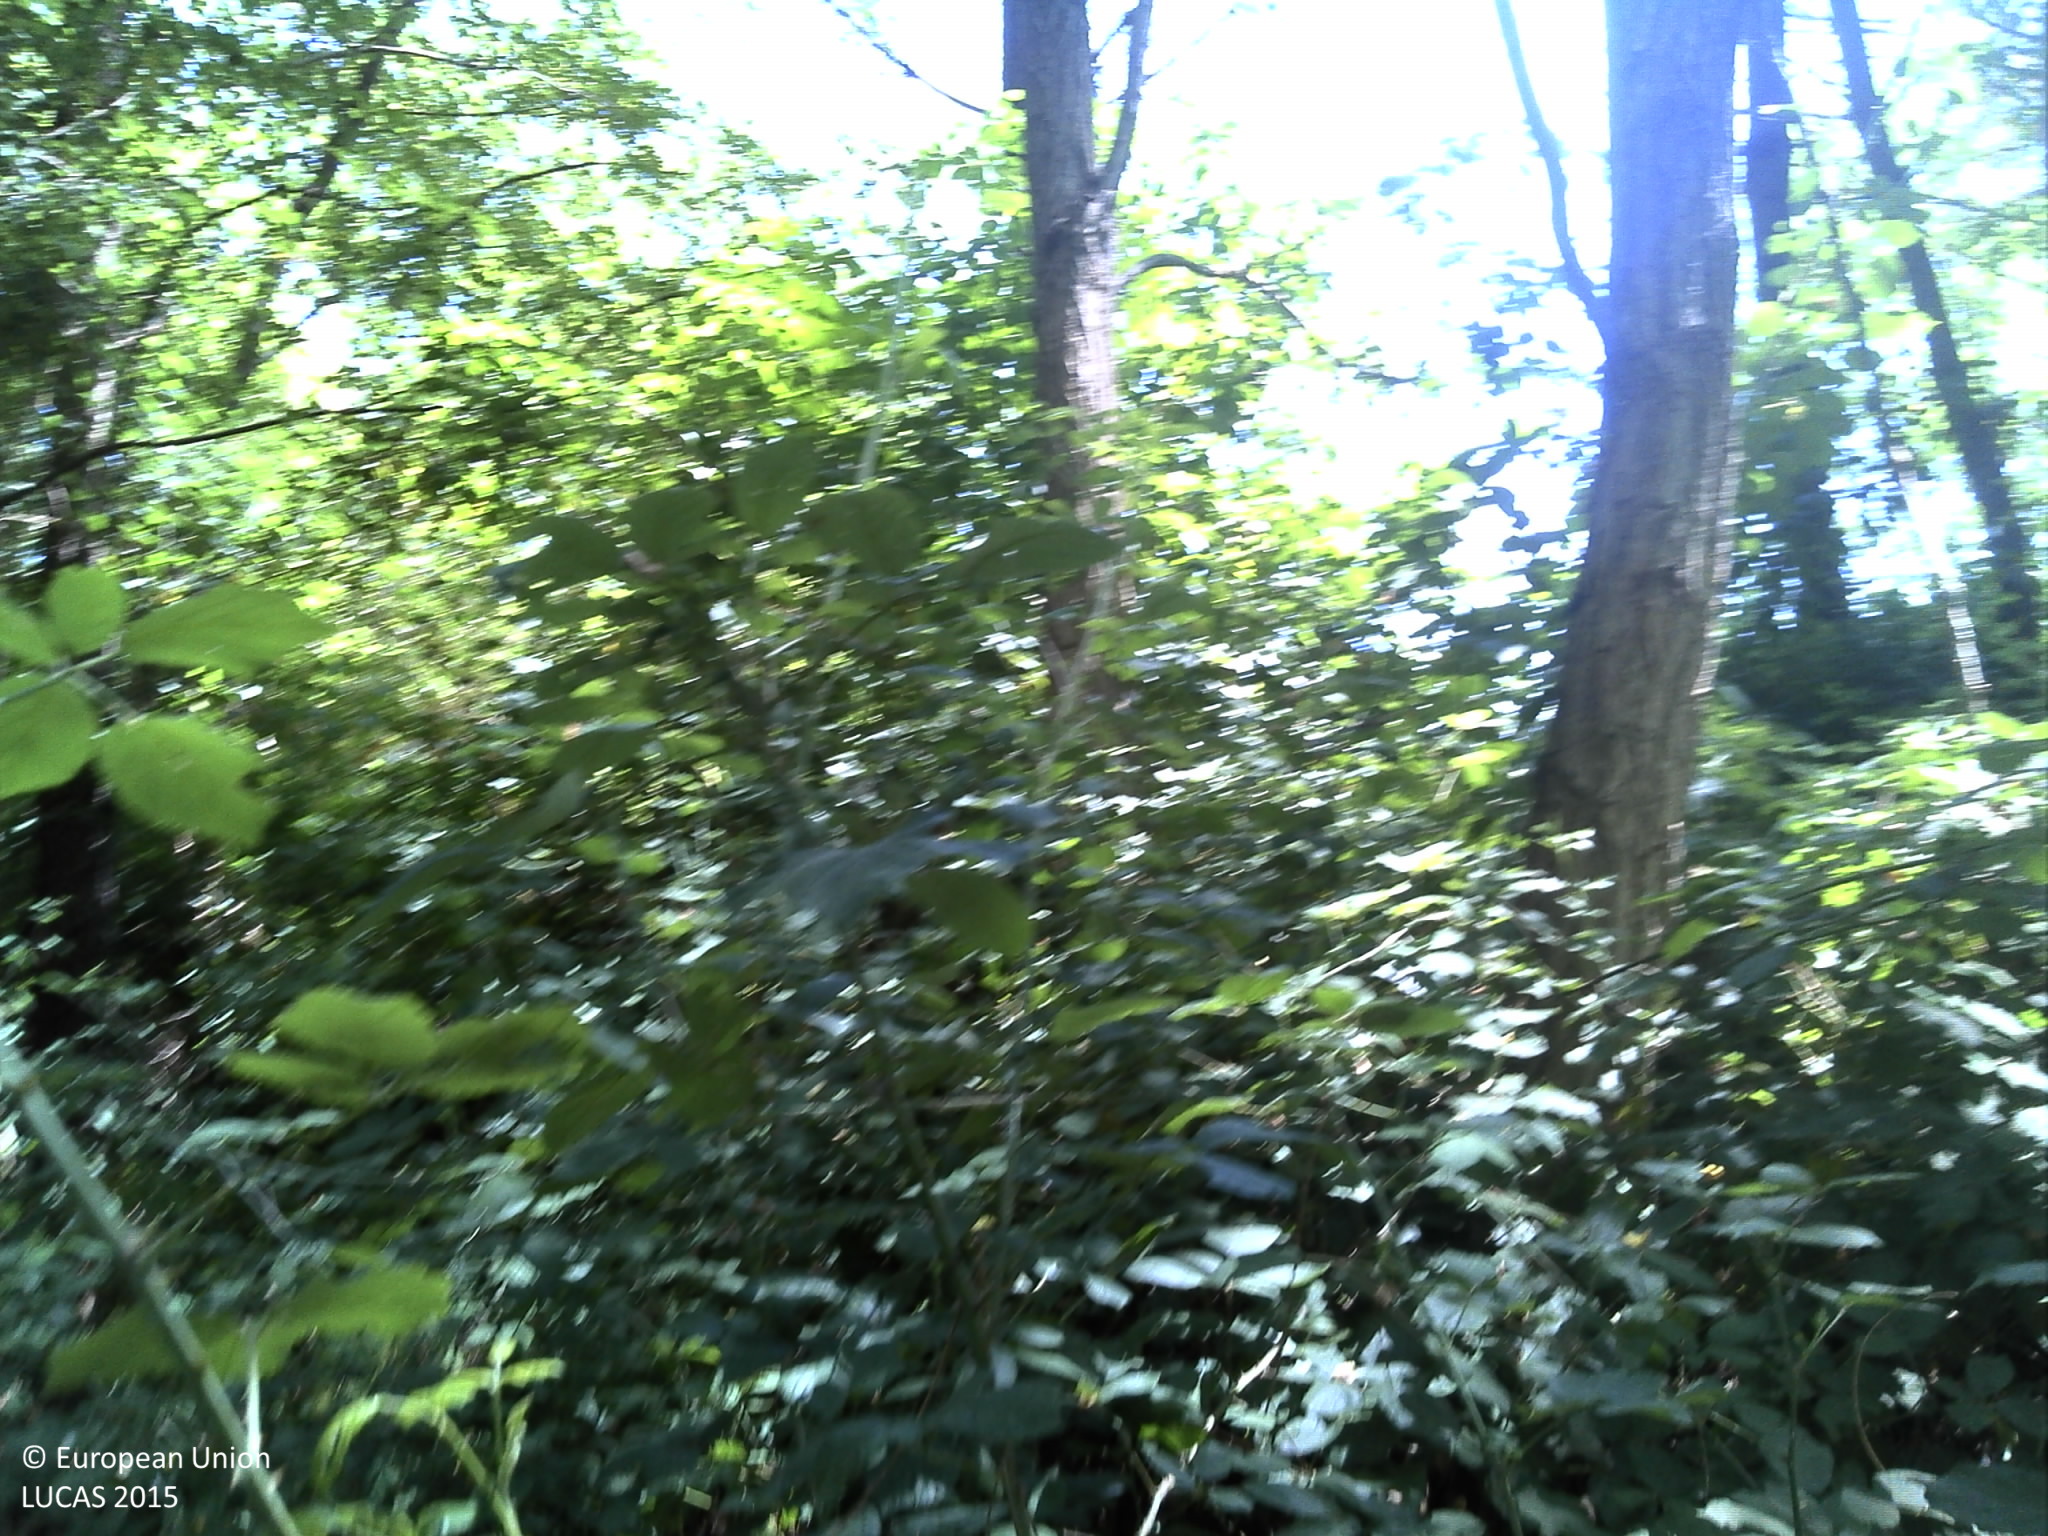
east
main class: Woodland
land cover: Broadleaved woodland
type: floodplain forest
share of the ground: > 75 %
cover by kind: broadleaved forest trees 70 %, shrubs 20 %, herbaceous plants 5 %, lichens and mosses 5 %
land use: Forestry
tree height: > 5 m
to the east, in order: Broadleaved woodland; Tracks; Fences; Grassland with sparse tree/shrub cover; Artificial constructions in urban areas; Grassland with sparse tree/shrub cover; Broadleaved woodland; Rivers and streams; Broadleaved woodland
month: July
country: FR
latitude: 44.4132
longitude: -0.3494
